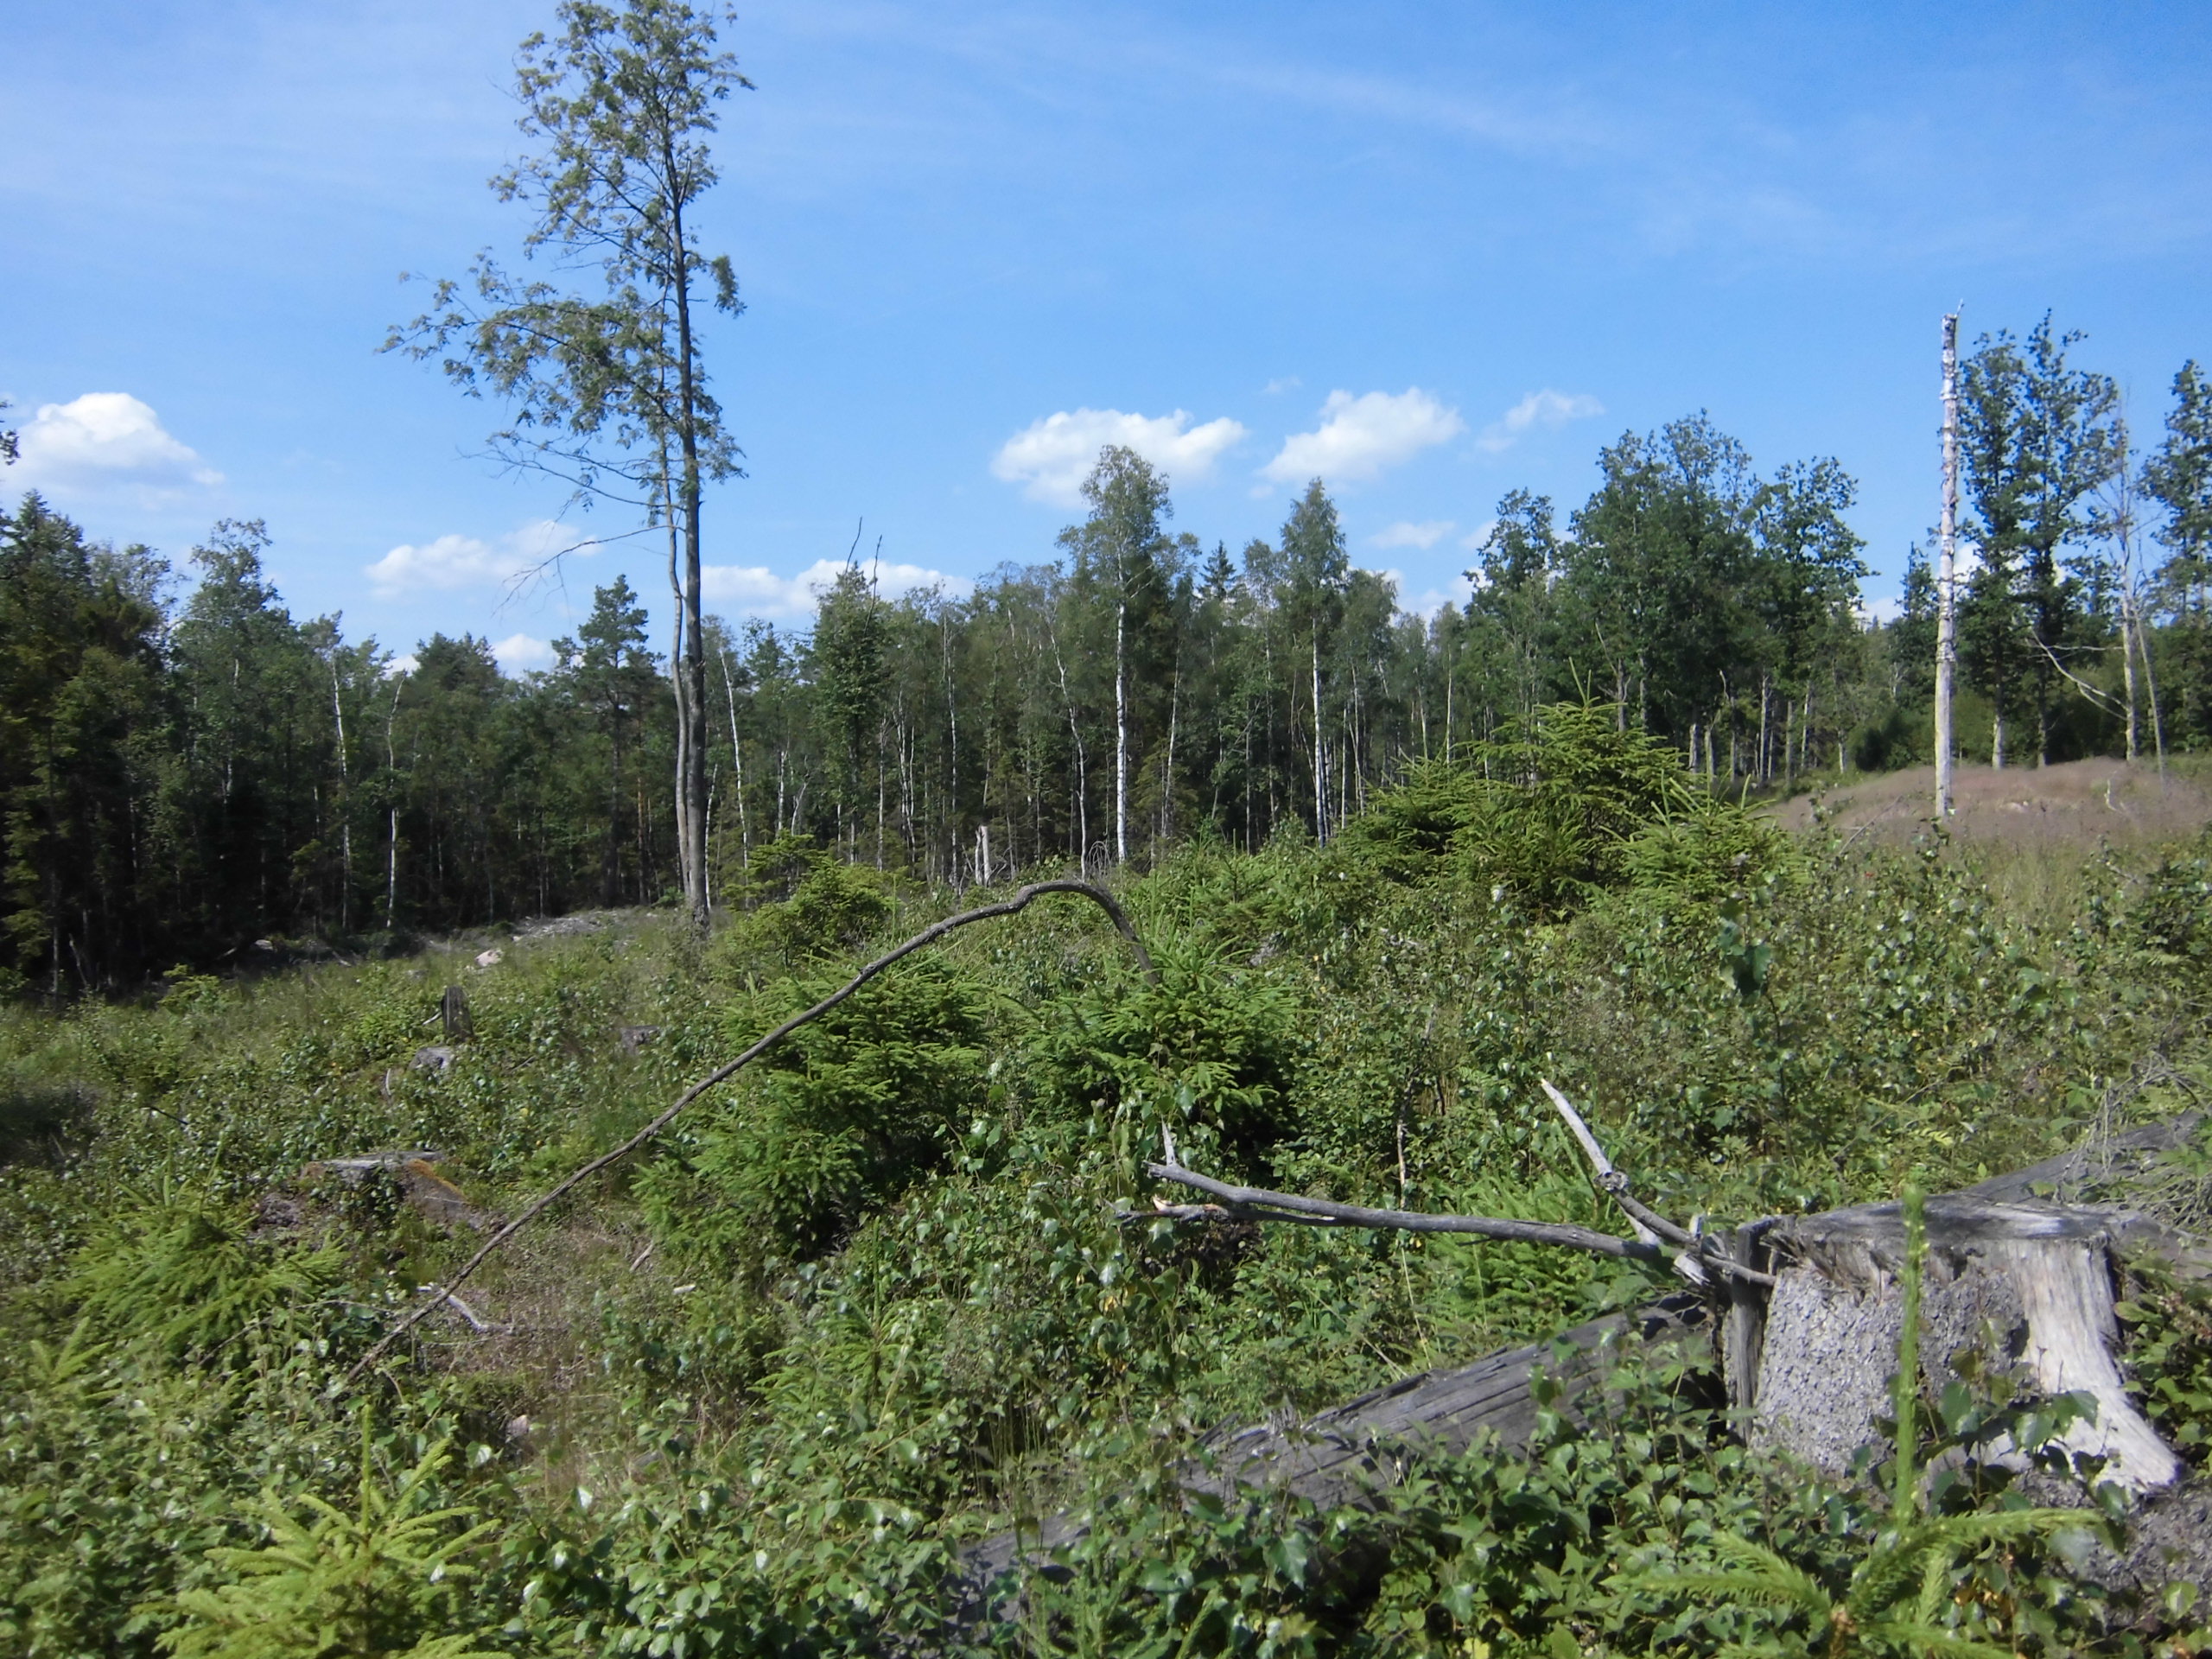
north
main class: Woodland
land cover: Spruce dominated mixed woodland
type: boreal forest
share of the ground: 25 - 50 %
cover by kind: coniferous forest trees 25 %, broadleaved forest trees 25 %, shrubs 25 %, herbaceous plants 15 %, lichens and mosses 10 %
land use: Forestry
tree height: < 5 m
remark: Clear cut
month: July
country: SE
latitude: 57.2652
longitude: 14.3900
